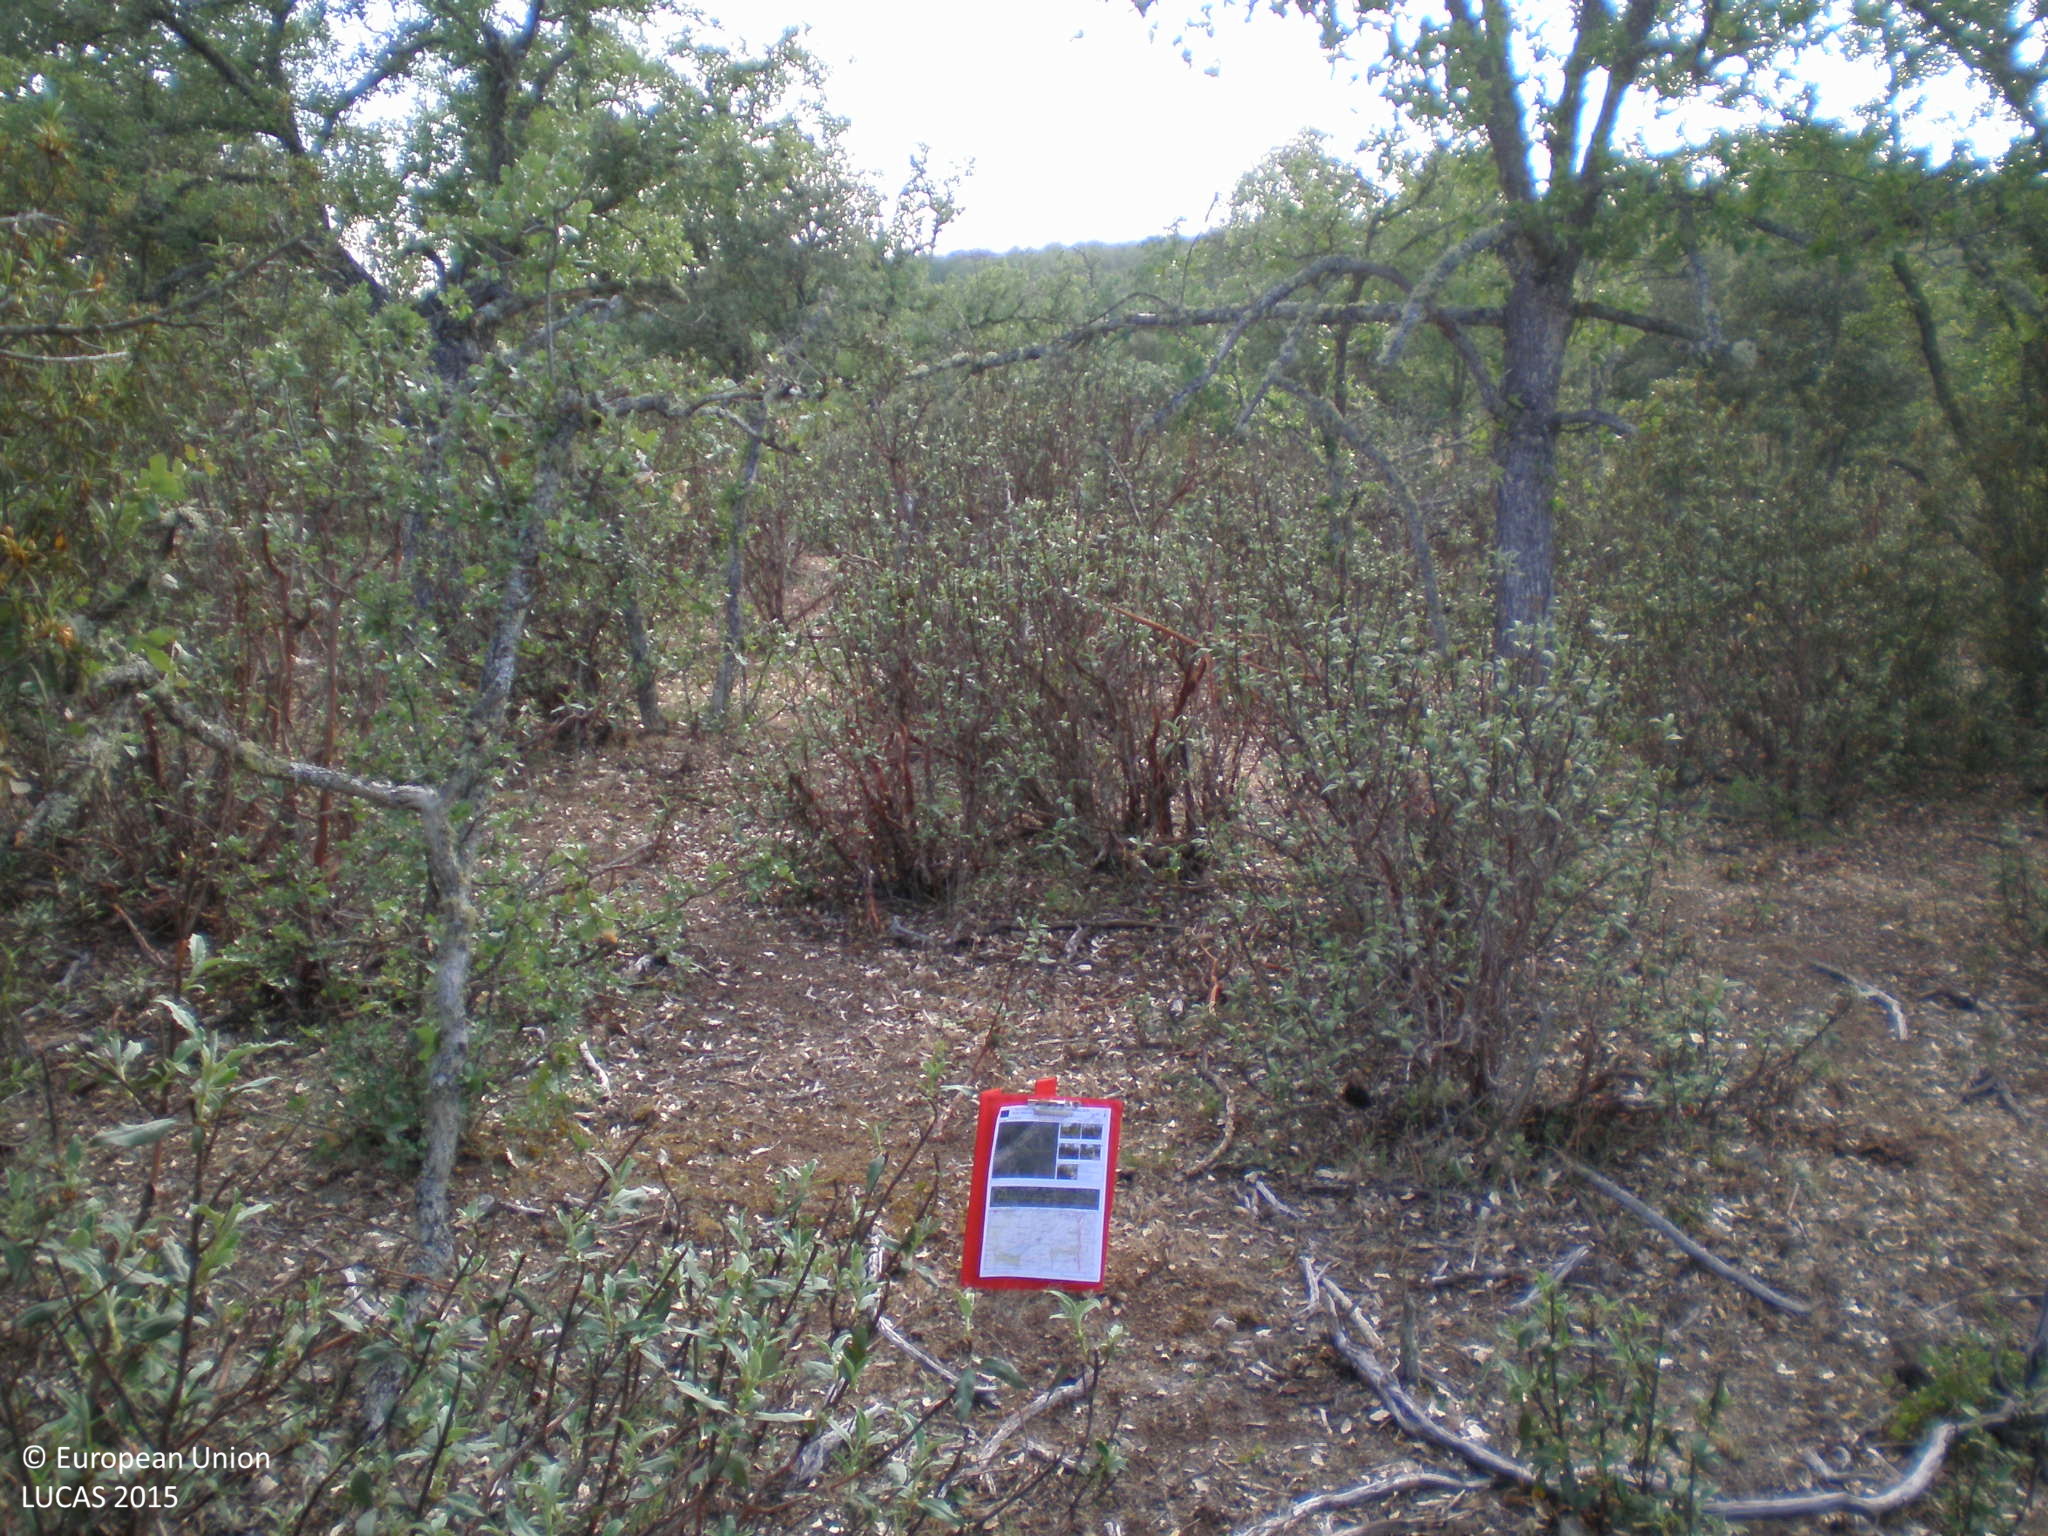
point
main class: Woodland
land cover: Broadleaved woodland
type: broadleaved evergreen forest
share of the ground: > 75 %
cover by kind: broadleaved forest trees 90 %, herbaceous plants 10 %
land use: Forestry
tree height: > 5 m
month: June
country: ES
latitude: 41.2296
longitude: -5.7467
